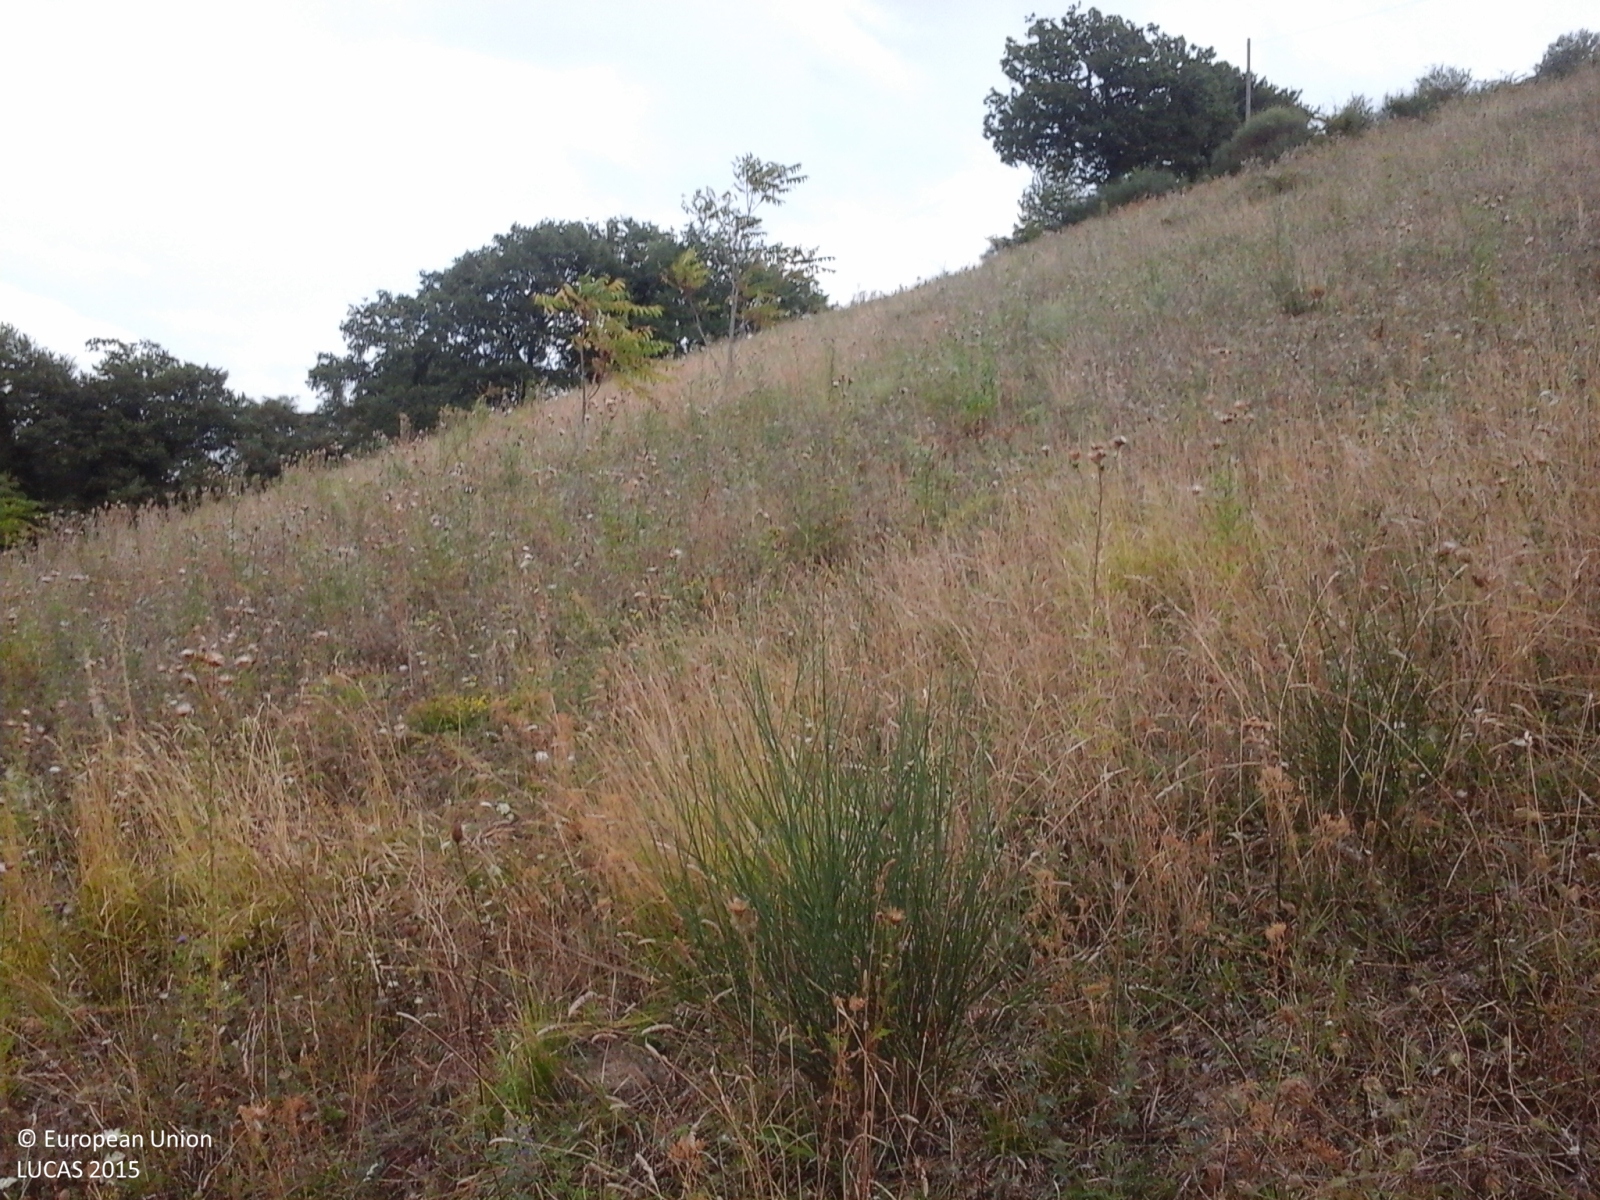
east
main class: Cropland
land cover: Sunflower
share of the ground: 25 - 50 %
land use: Agriculture (excluding fallow land and kitchen gardens)
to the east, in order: Sunflower; Broadleaved woodland; Sunflower; Broadleaved woodland; Shrubland with sparse tree cover
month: August
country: IT
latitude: 43.4176
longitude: 13.1661
